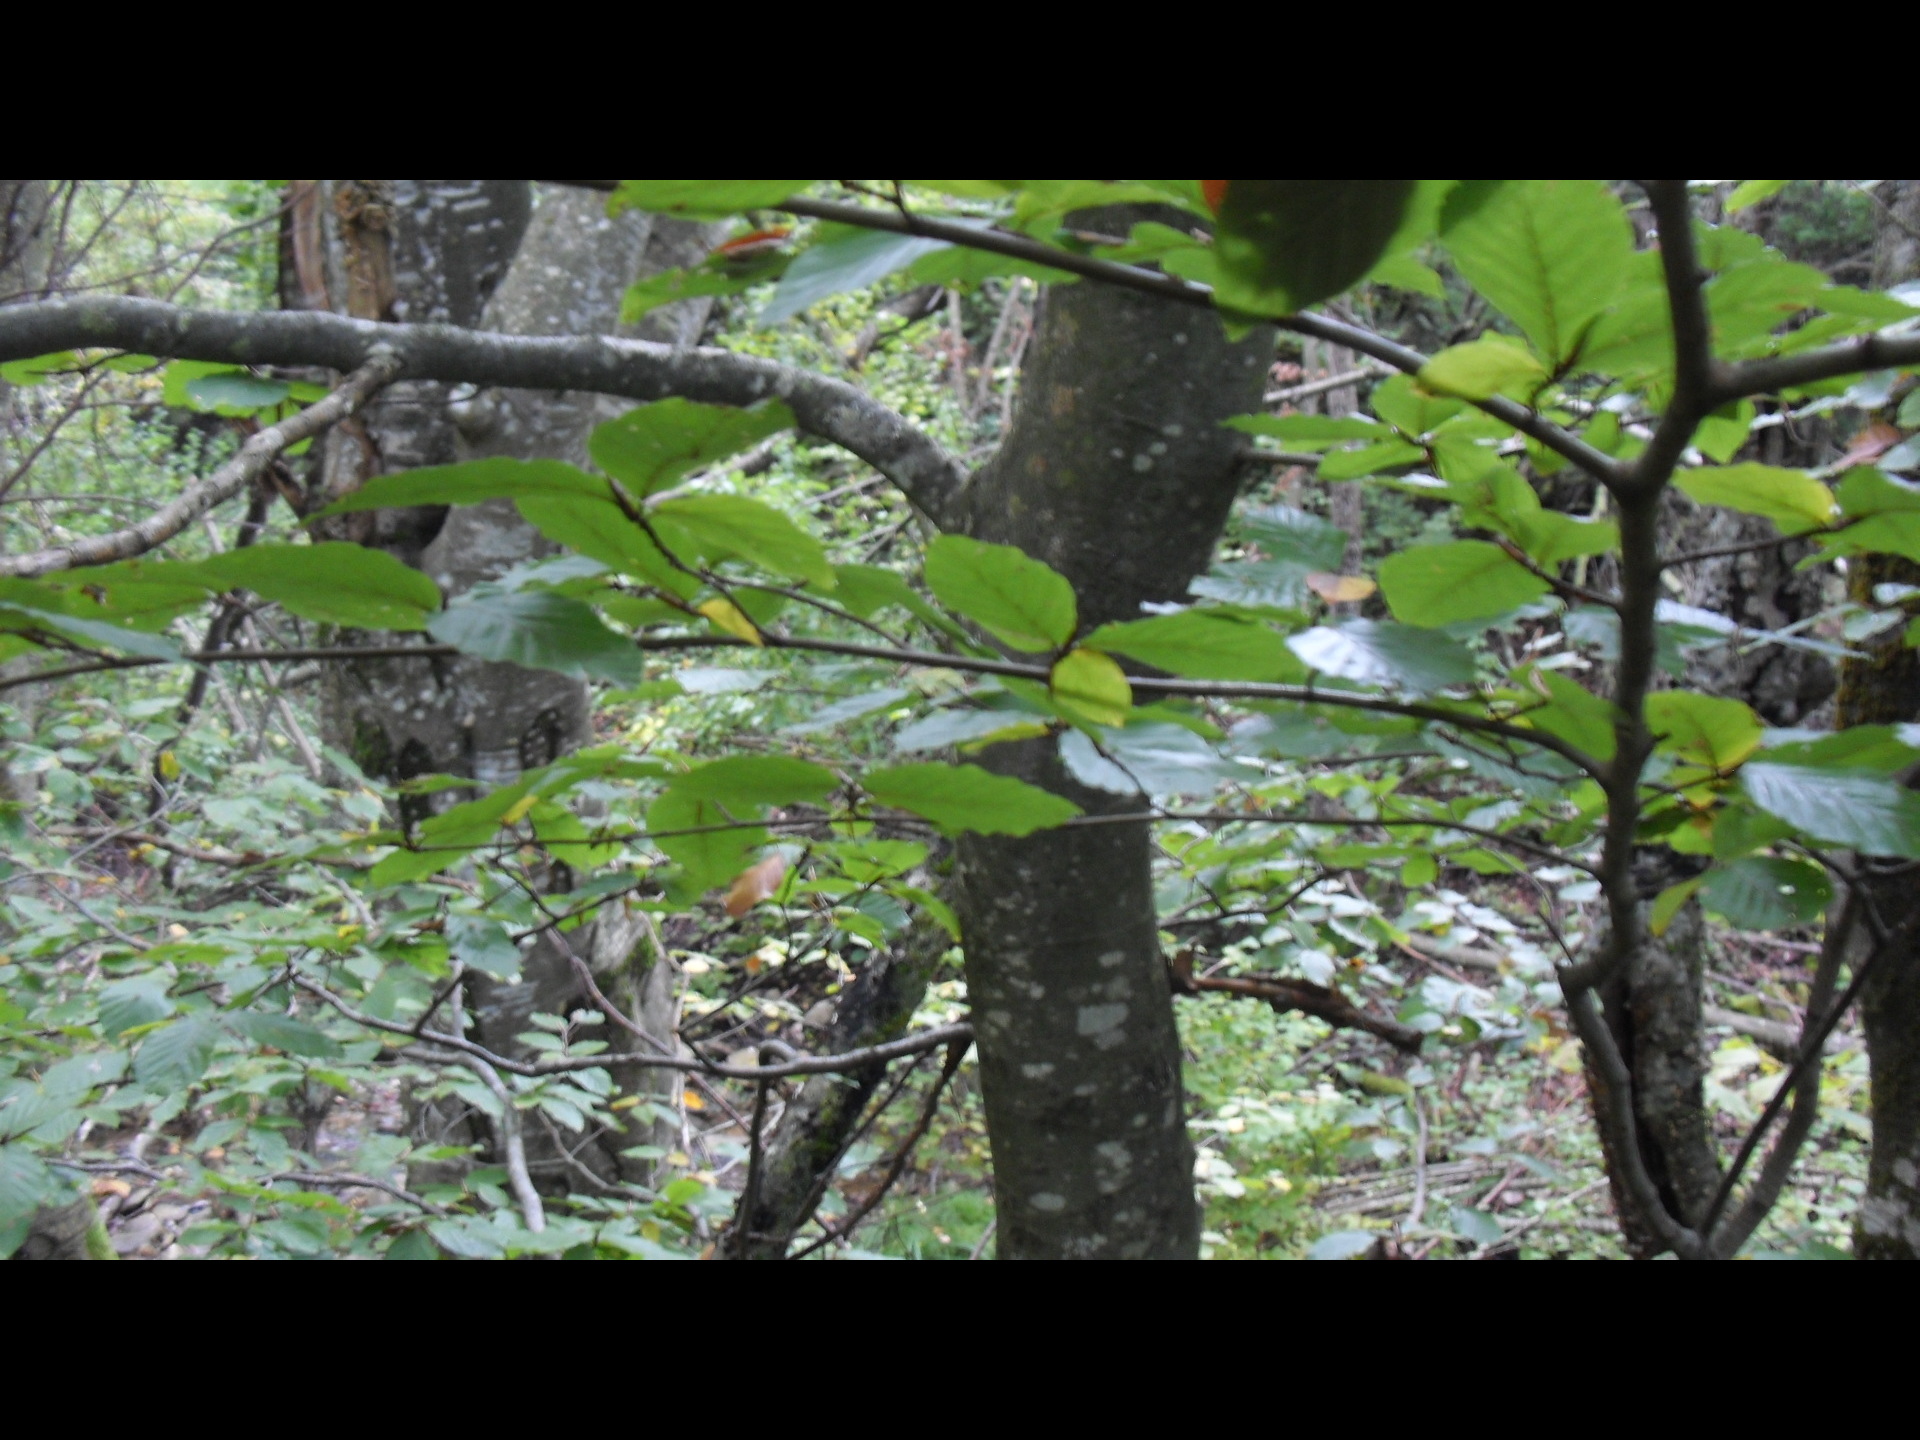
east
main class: Woodland
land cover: Broadleaved woodland
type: mesophytic deciduous forest
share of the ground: > 75 %
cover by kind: broadleaved forest trees 95 %, shrubs 5 %
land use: Forestry
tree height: > 5 m
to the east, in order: Broadleaved woodland; Tracks; Broadleaved woodland; Tracks; Broadleaved woodland; Tracks; Broadleaved woodland
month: October
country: BG
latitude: 43.5109
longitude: 22.5618
